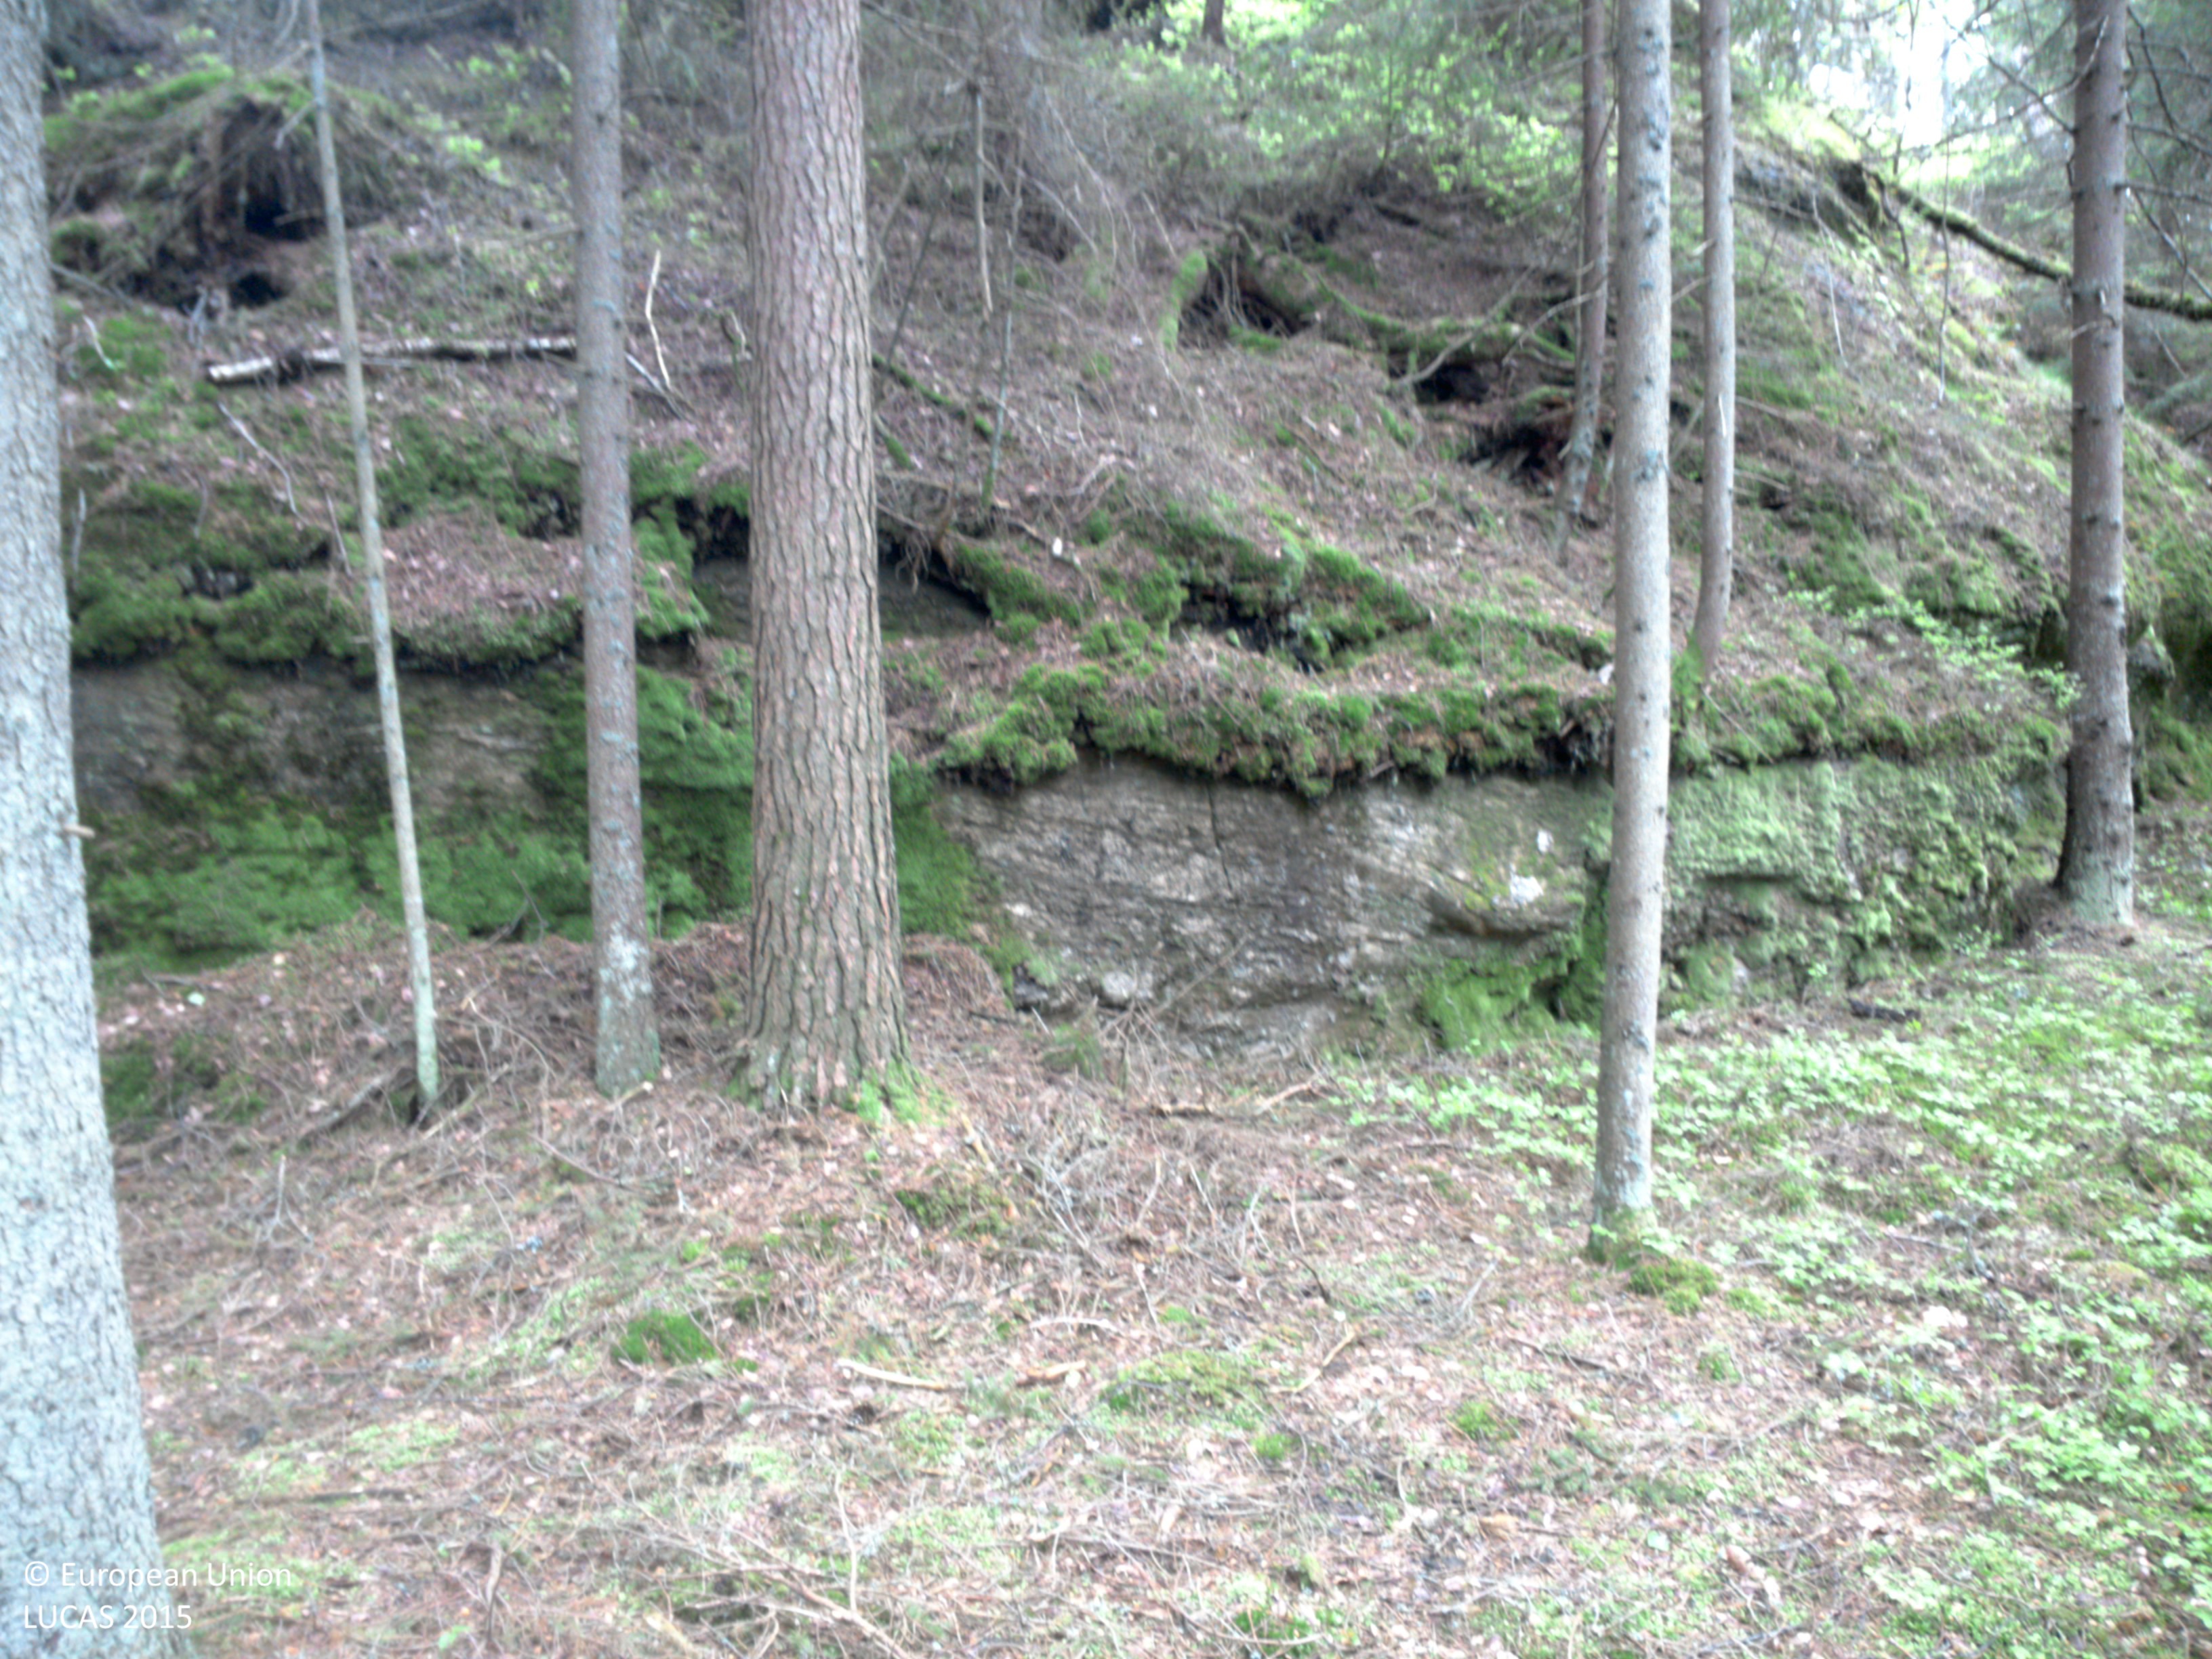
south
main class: Woodland
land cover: Spruce dominated coniferous woodland
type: boreal forest
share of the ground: 50 - 75 %
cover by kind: coniferous forest trees 65 %, herbaceous plants 30 %, broadleaved forest trees 5 %
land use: Forestry
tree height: > 5 m
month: May
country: SE
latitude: 58.2629
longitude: 11.6840
